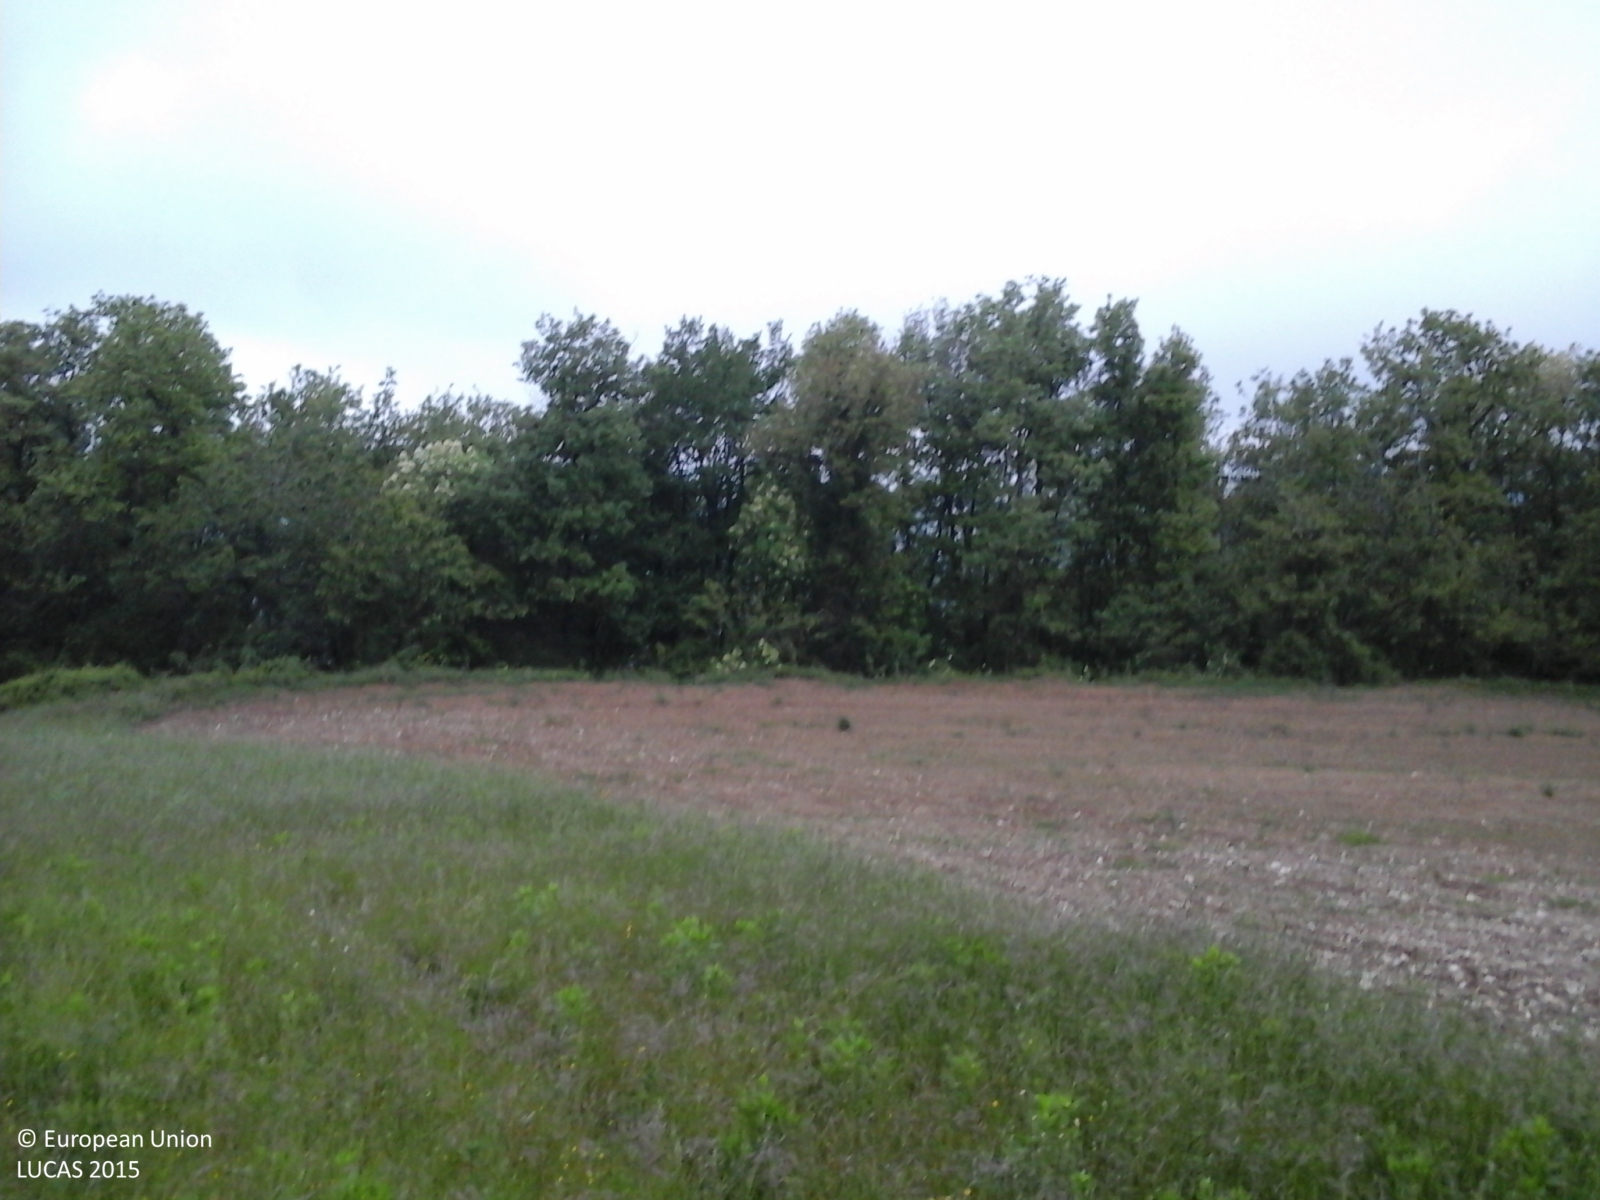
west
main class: Cropland
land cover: Other leguminous and mixtures for fodder
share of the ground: > 75 %
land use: Agriculture (excluding fallow land and kitchen gardens)
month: April
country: IT
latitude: 44.8897
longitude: 9.3808
